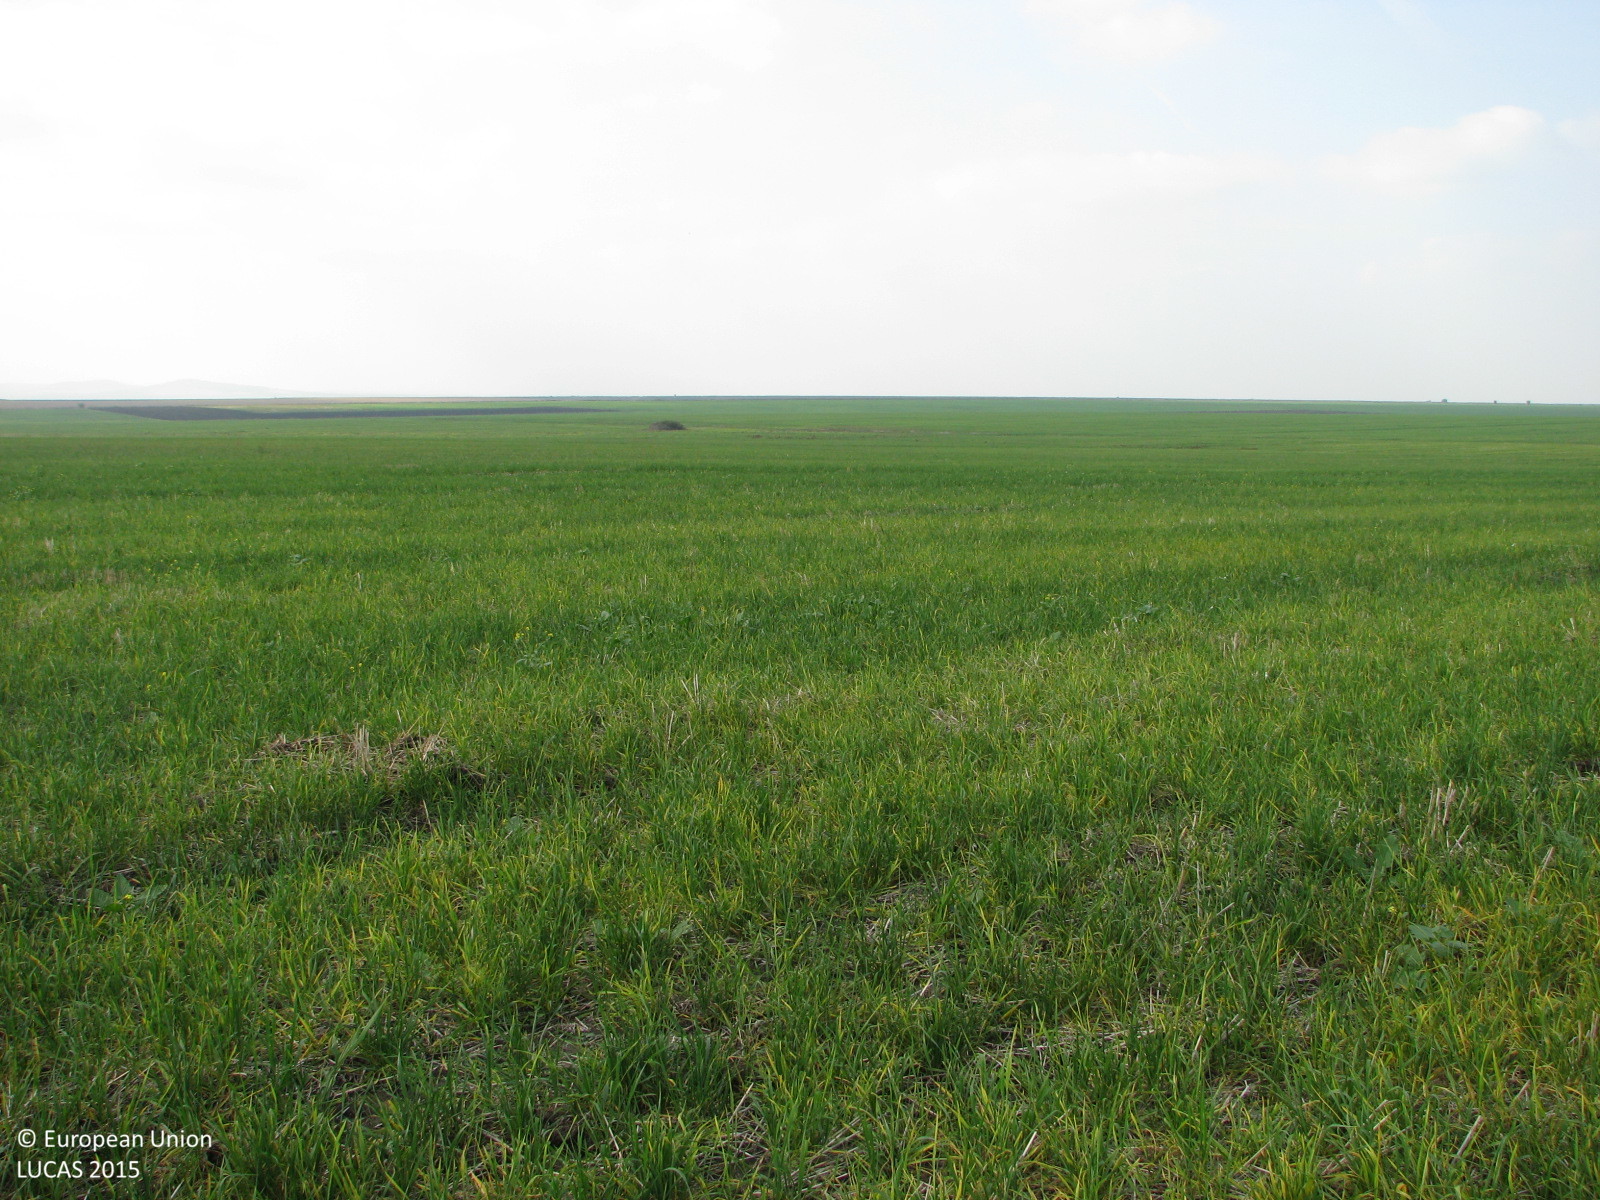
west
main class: Cropland
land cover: Common wheat
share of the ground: > 75 %
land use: Agriculture (excluding fallow land and kitchen gardens)
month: October
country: BG
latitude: 42.3403
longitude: 26.4880
